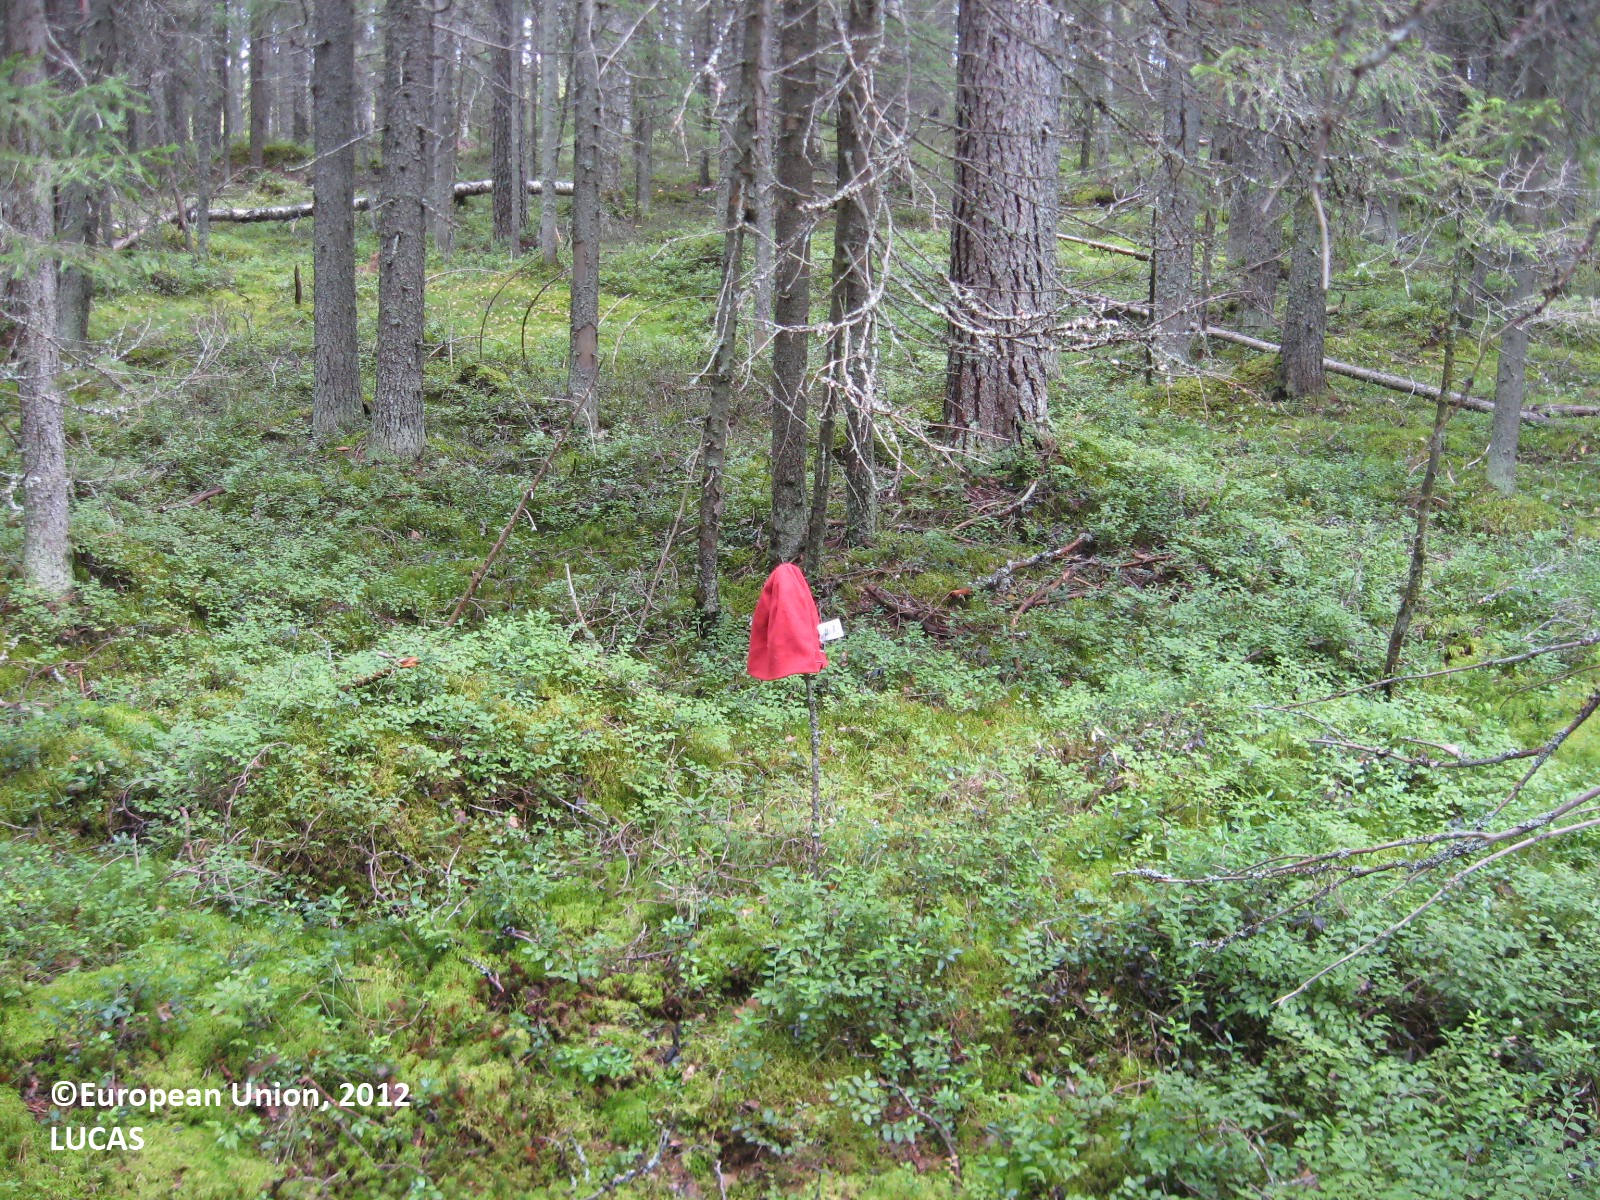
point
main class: Woodland
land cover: Spruce dominated coniferous woodland
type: boreal forest
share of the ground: > 75 %
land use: Forestry
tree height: > 5 m
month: August
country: FI
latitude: 63.6016
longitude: 30.1925
